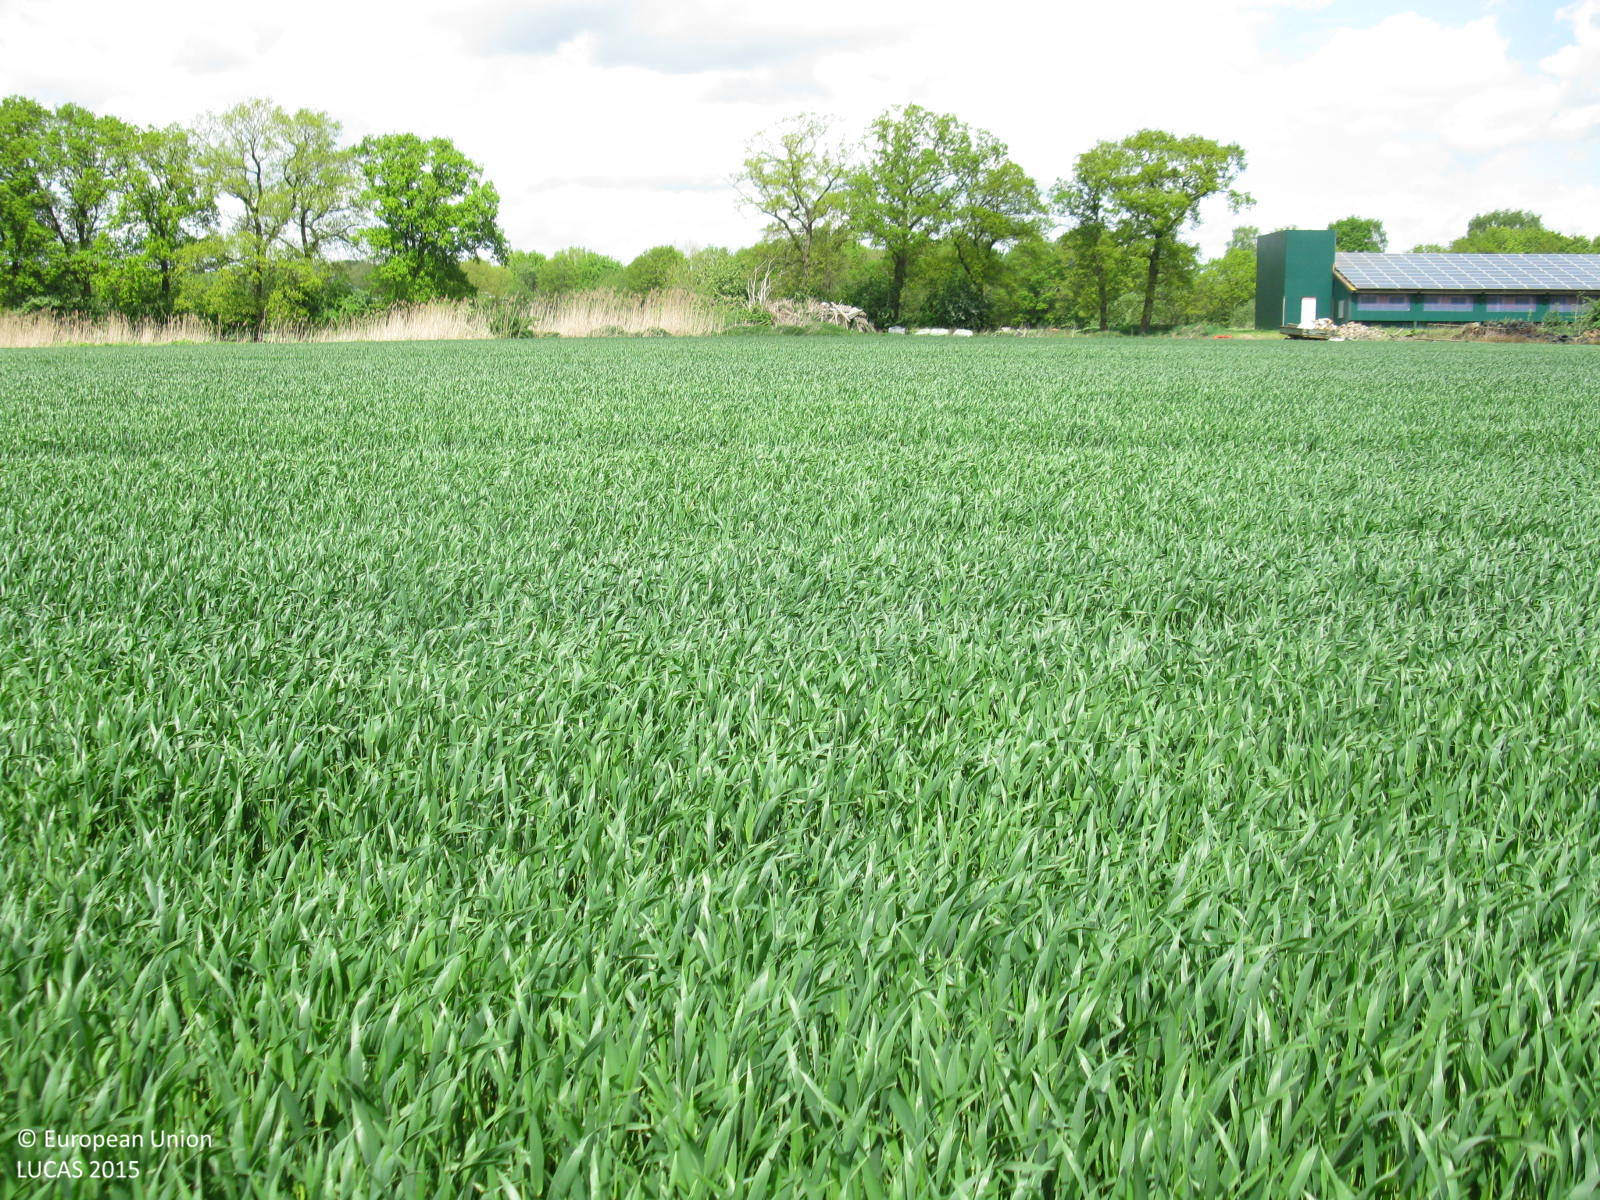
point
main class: Cropland
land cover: Triticale
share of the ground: > 75 %
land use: Agriculture (excluding fallow land and kitchen gardens)
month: May
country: DE
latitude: 52.9763
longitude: 7.3049
